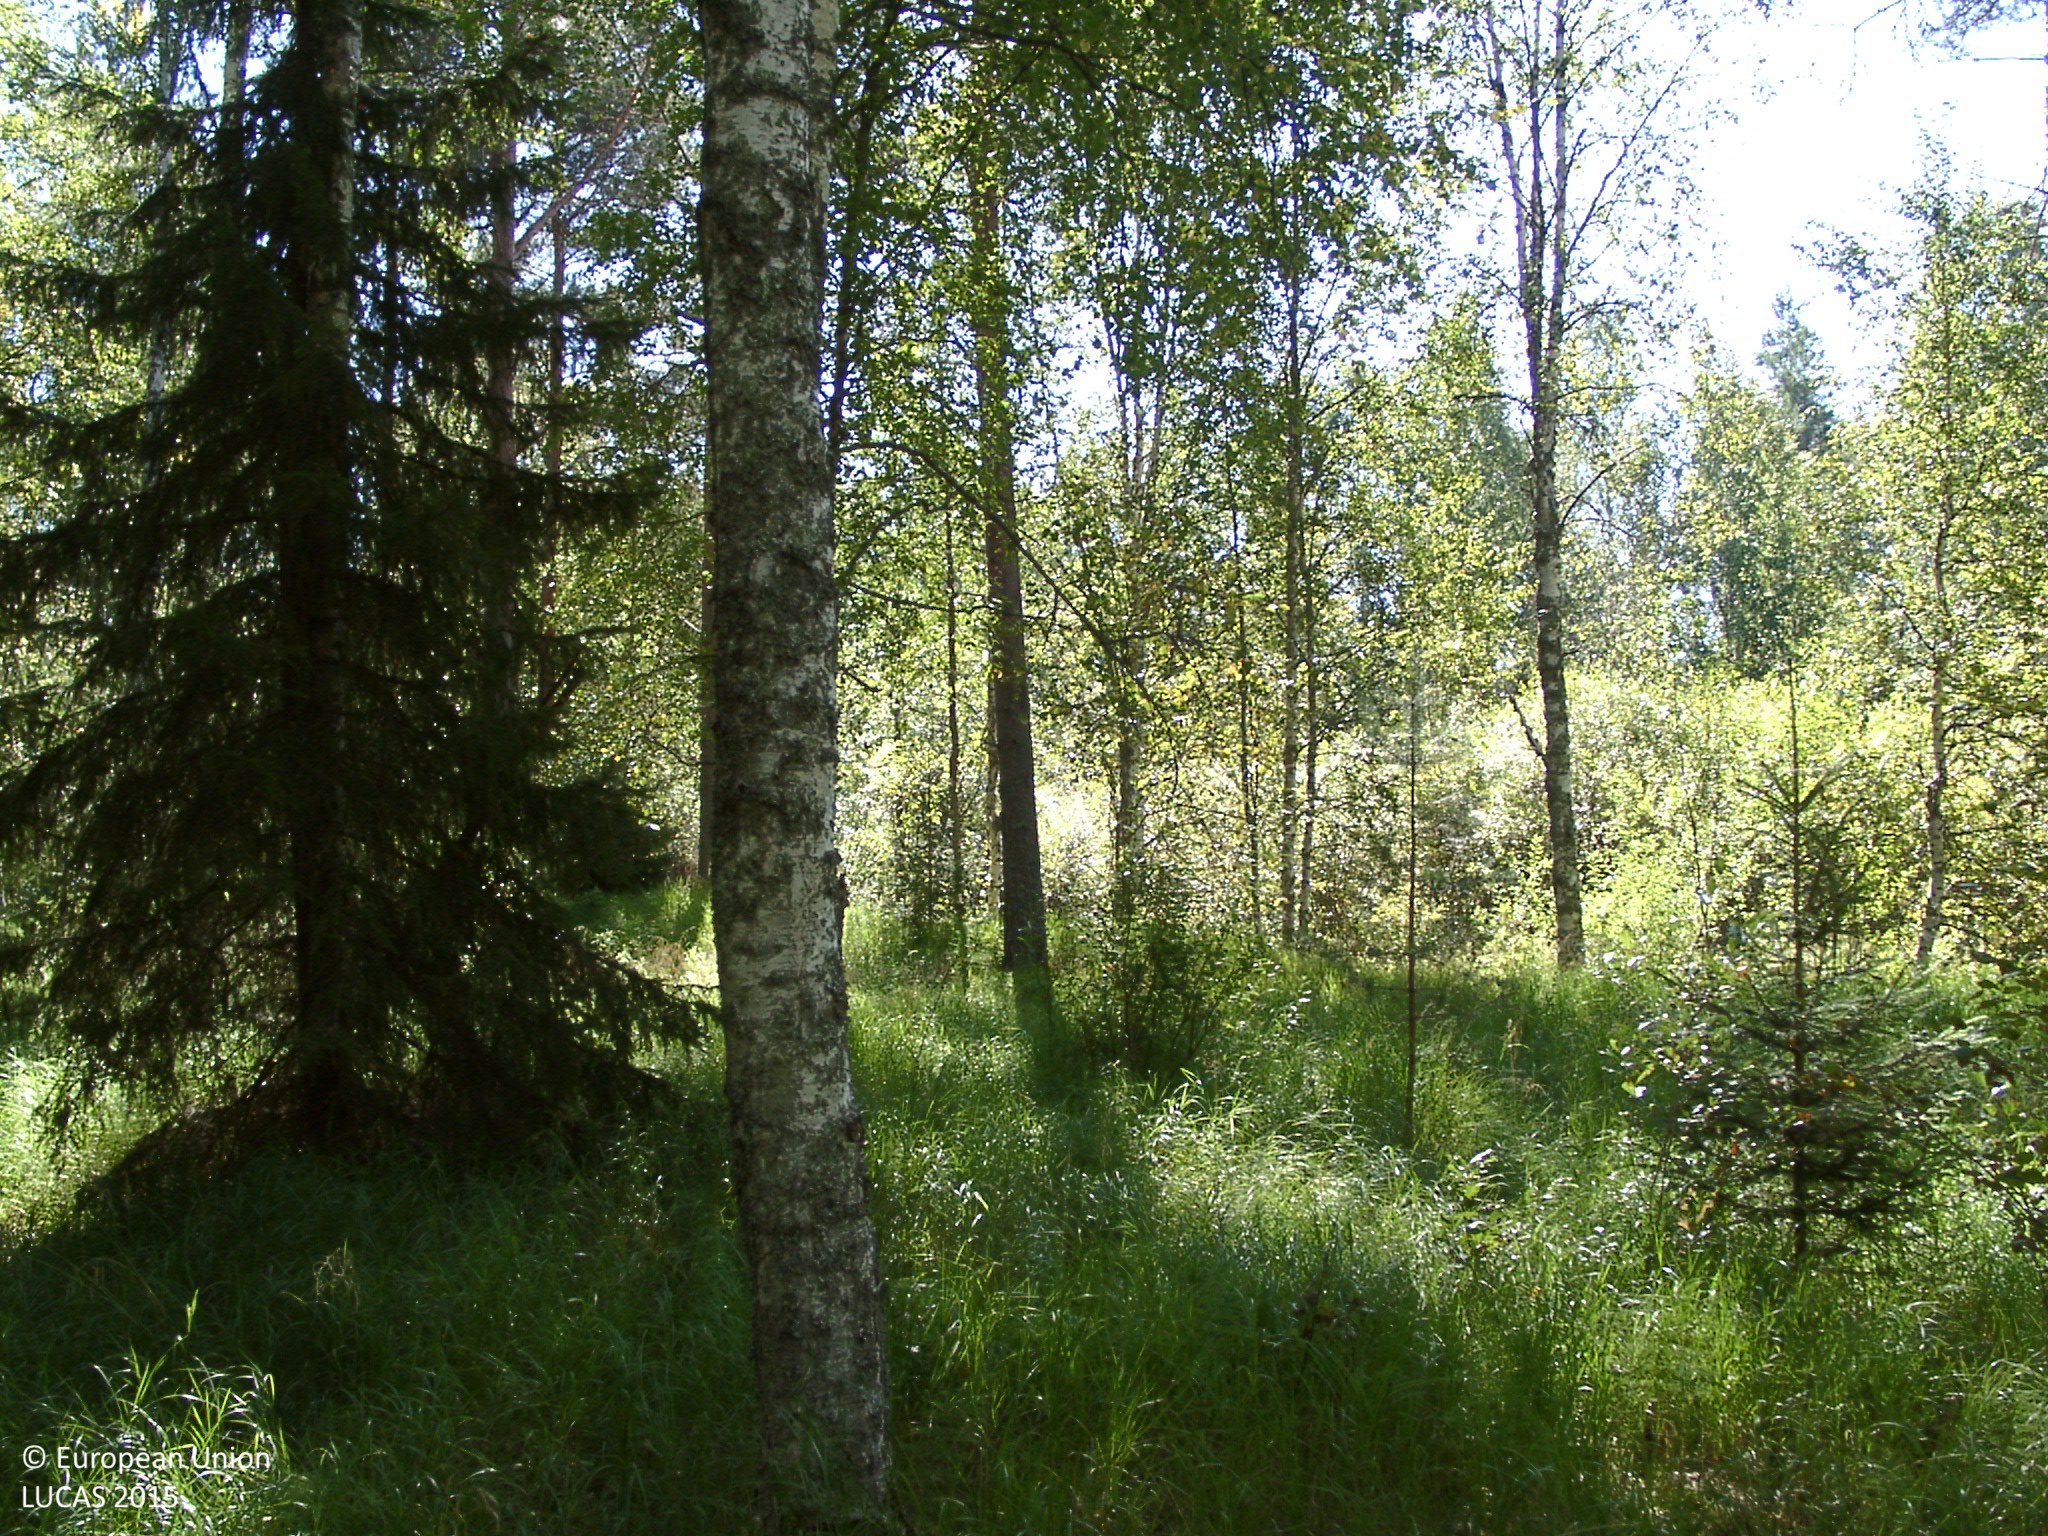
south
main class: Woodland
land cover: Other mixed woodland
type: boreal forest
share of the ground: 50 - 75 %
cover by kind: herbaceous plants 40 %, coniferous forest trees 30 %, broadleaved forest trees 30 %
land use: Forestry
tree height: > 5 m
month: August
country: FI
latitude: 61.9689
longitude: 24.9633
